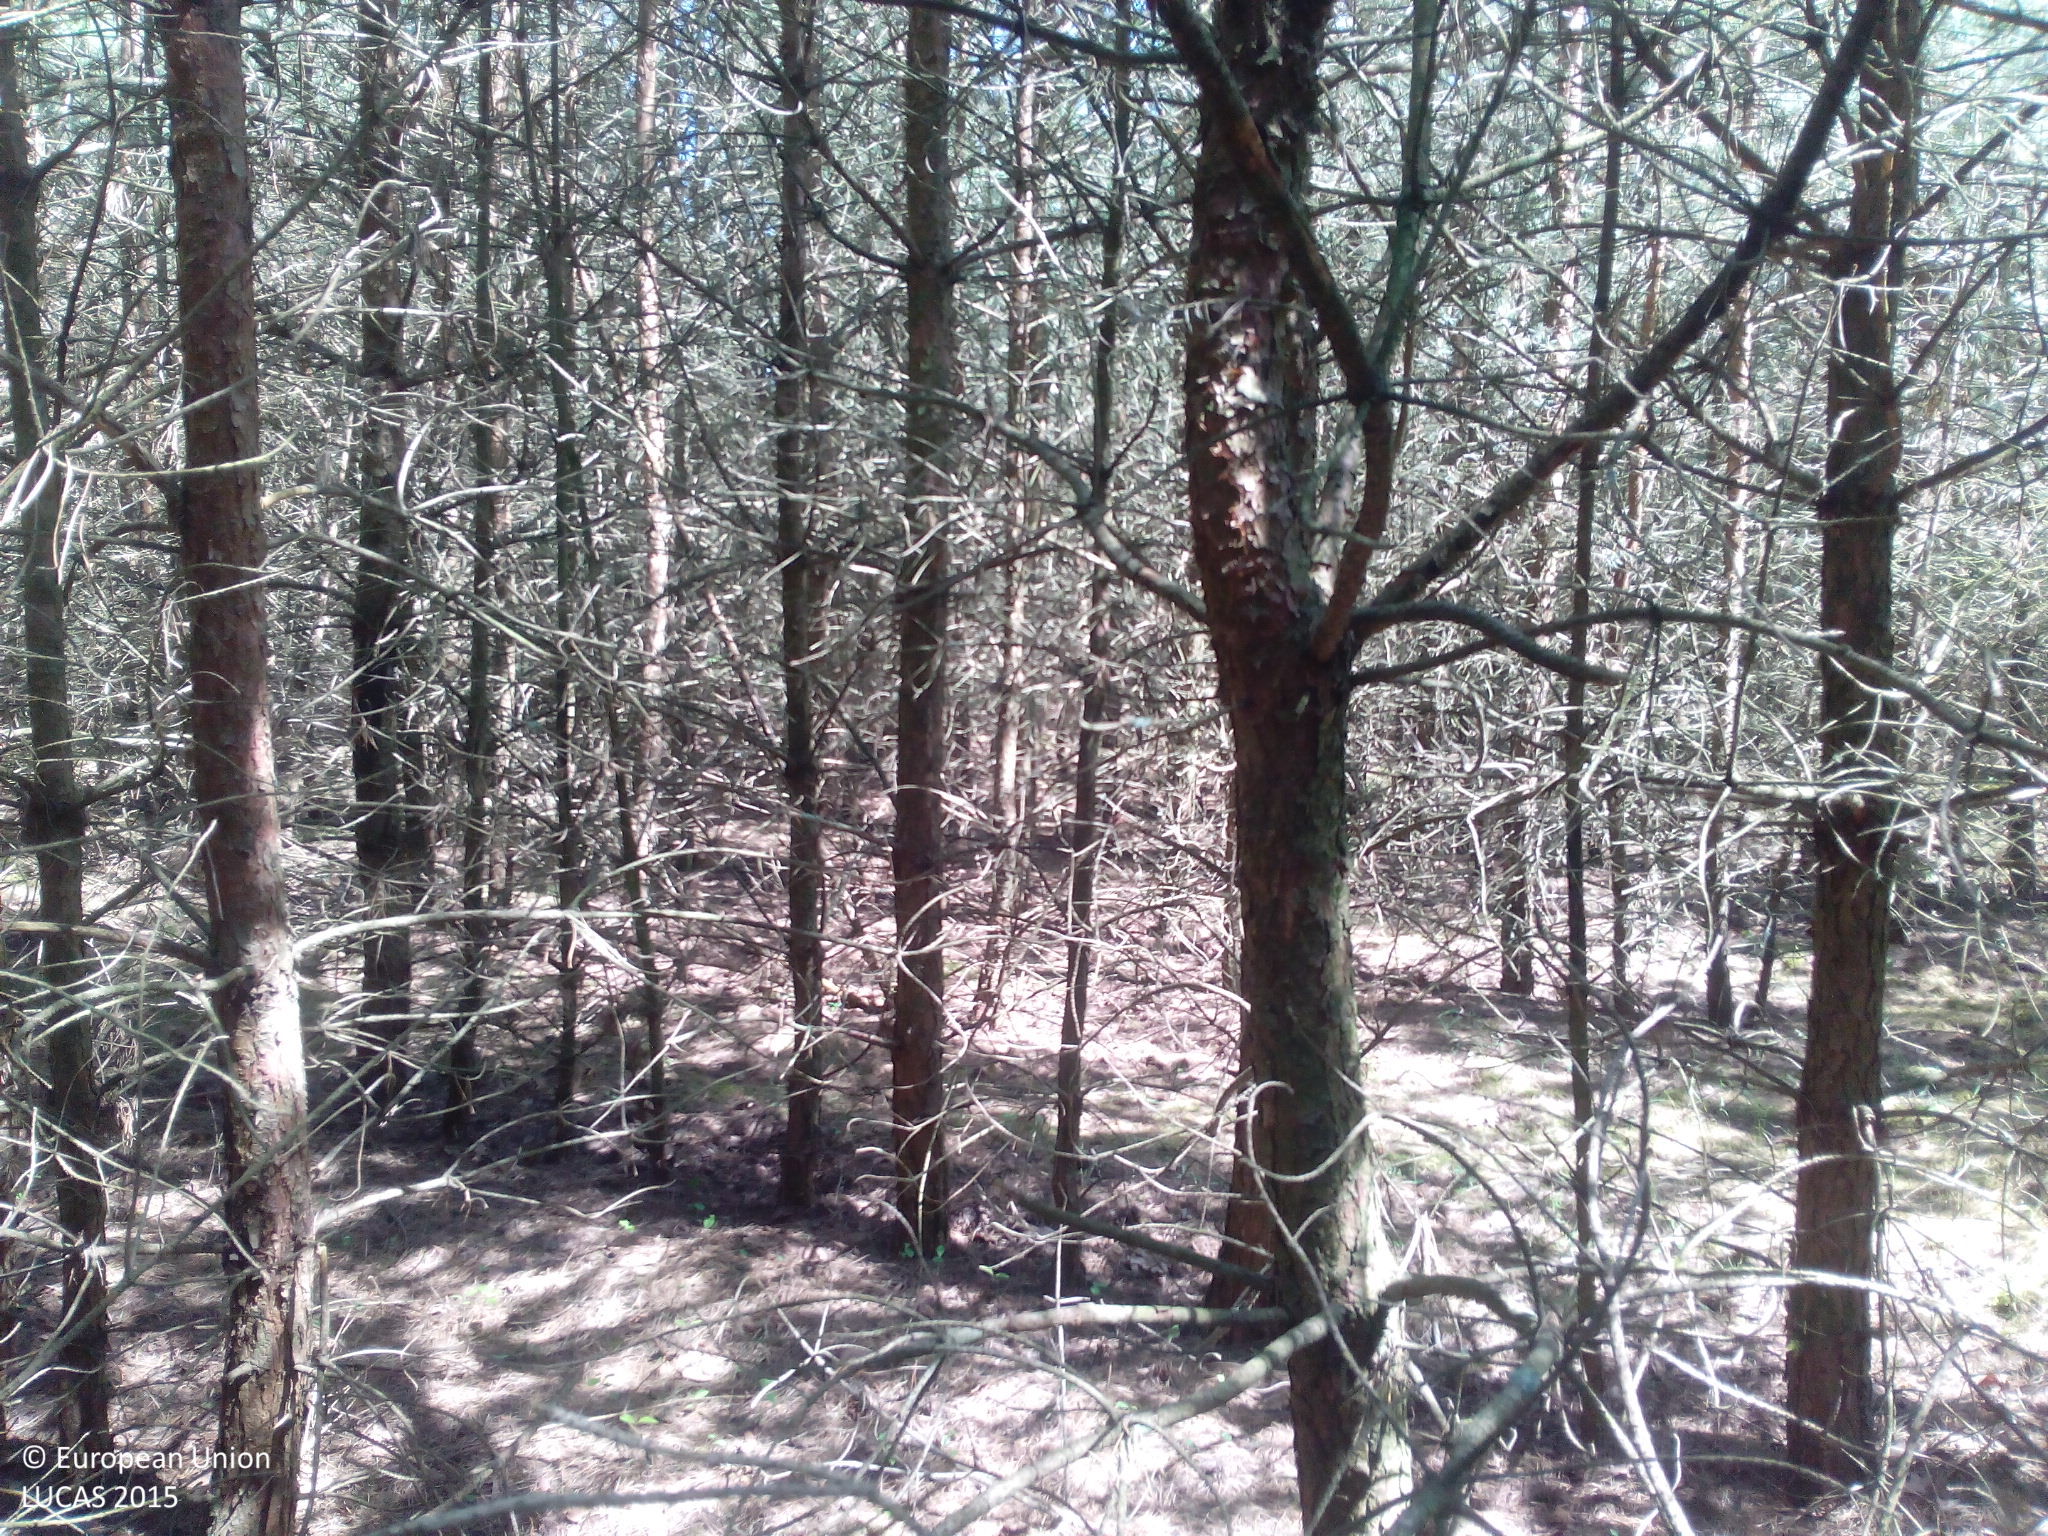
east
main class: Woodland
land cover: Pine dominated coniferous woodland
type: hemiboreal forest and nemoral coniferous forest and mixed broadleaved-coniferous forest
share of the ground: > 75 %
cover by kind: coniferous forest trees 85 %, consolidated bare surface 15 %
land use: Forestry
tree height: > 5 m
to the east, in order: Pine dominated coniferous woodland; Grassland without tree/shrub cover; Broadleaved woodland; Inland fresh running water; Pine dominated mixed woodland; Tracks; Pine dominated coniferous woodland
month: May
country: DE
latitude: 53.3924
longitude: 11.5182
